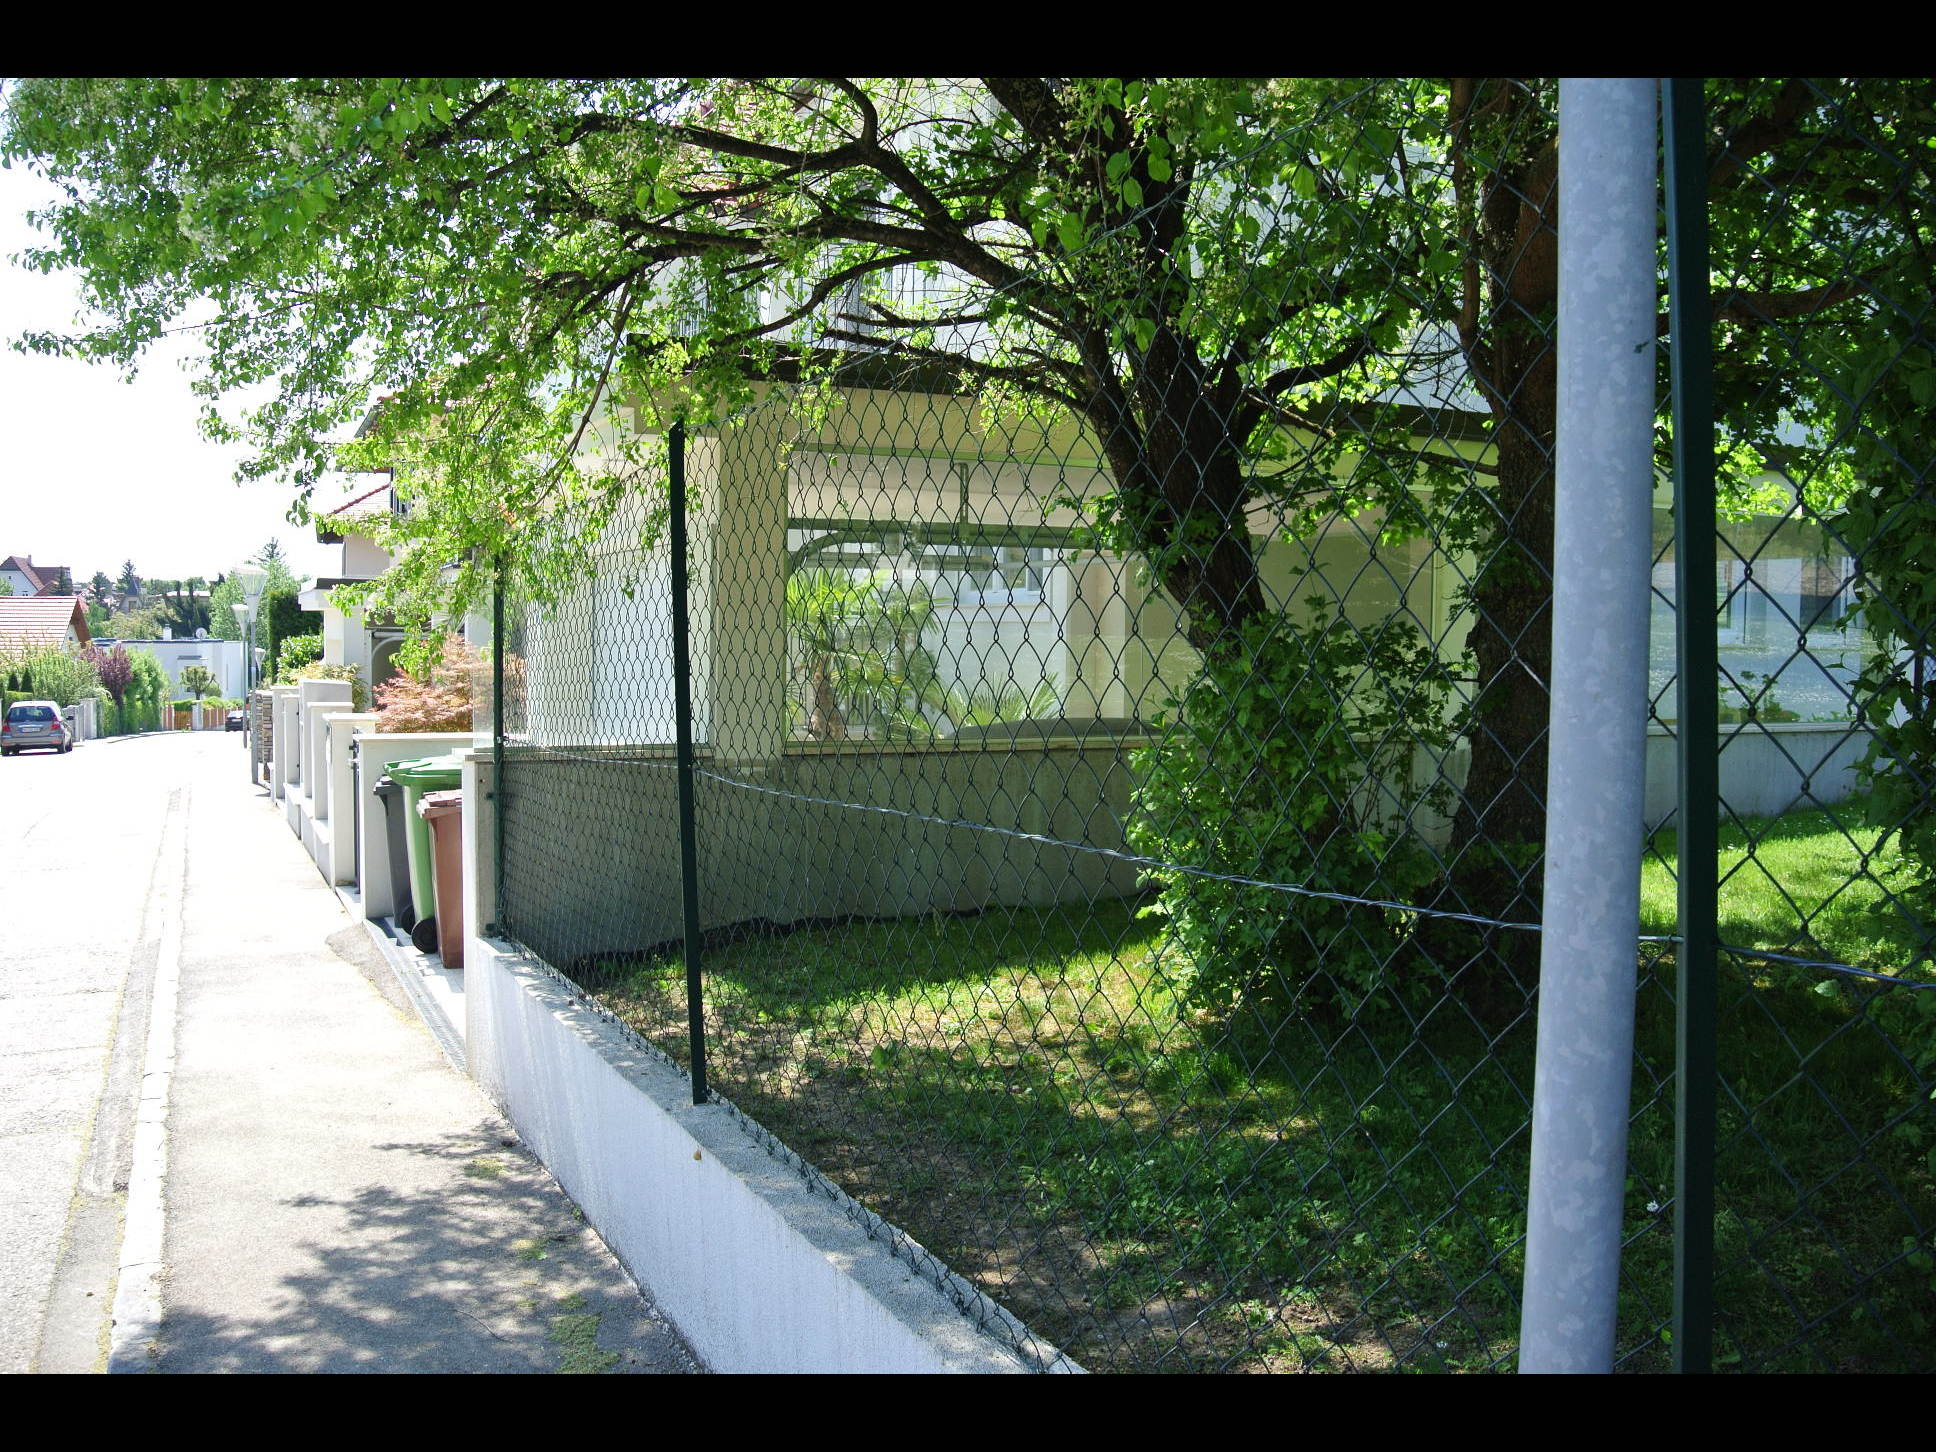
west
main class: Grassland
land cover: Grassland with sparse tree/shrub cover
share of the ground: > 75 %
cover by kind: herbaceous plants 85 %, shrubs 10 %, broadleaved forest trees 5 %
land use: Residential
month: May
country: AT
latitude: 48.1183
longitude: 16.2508
